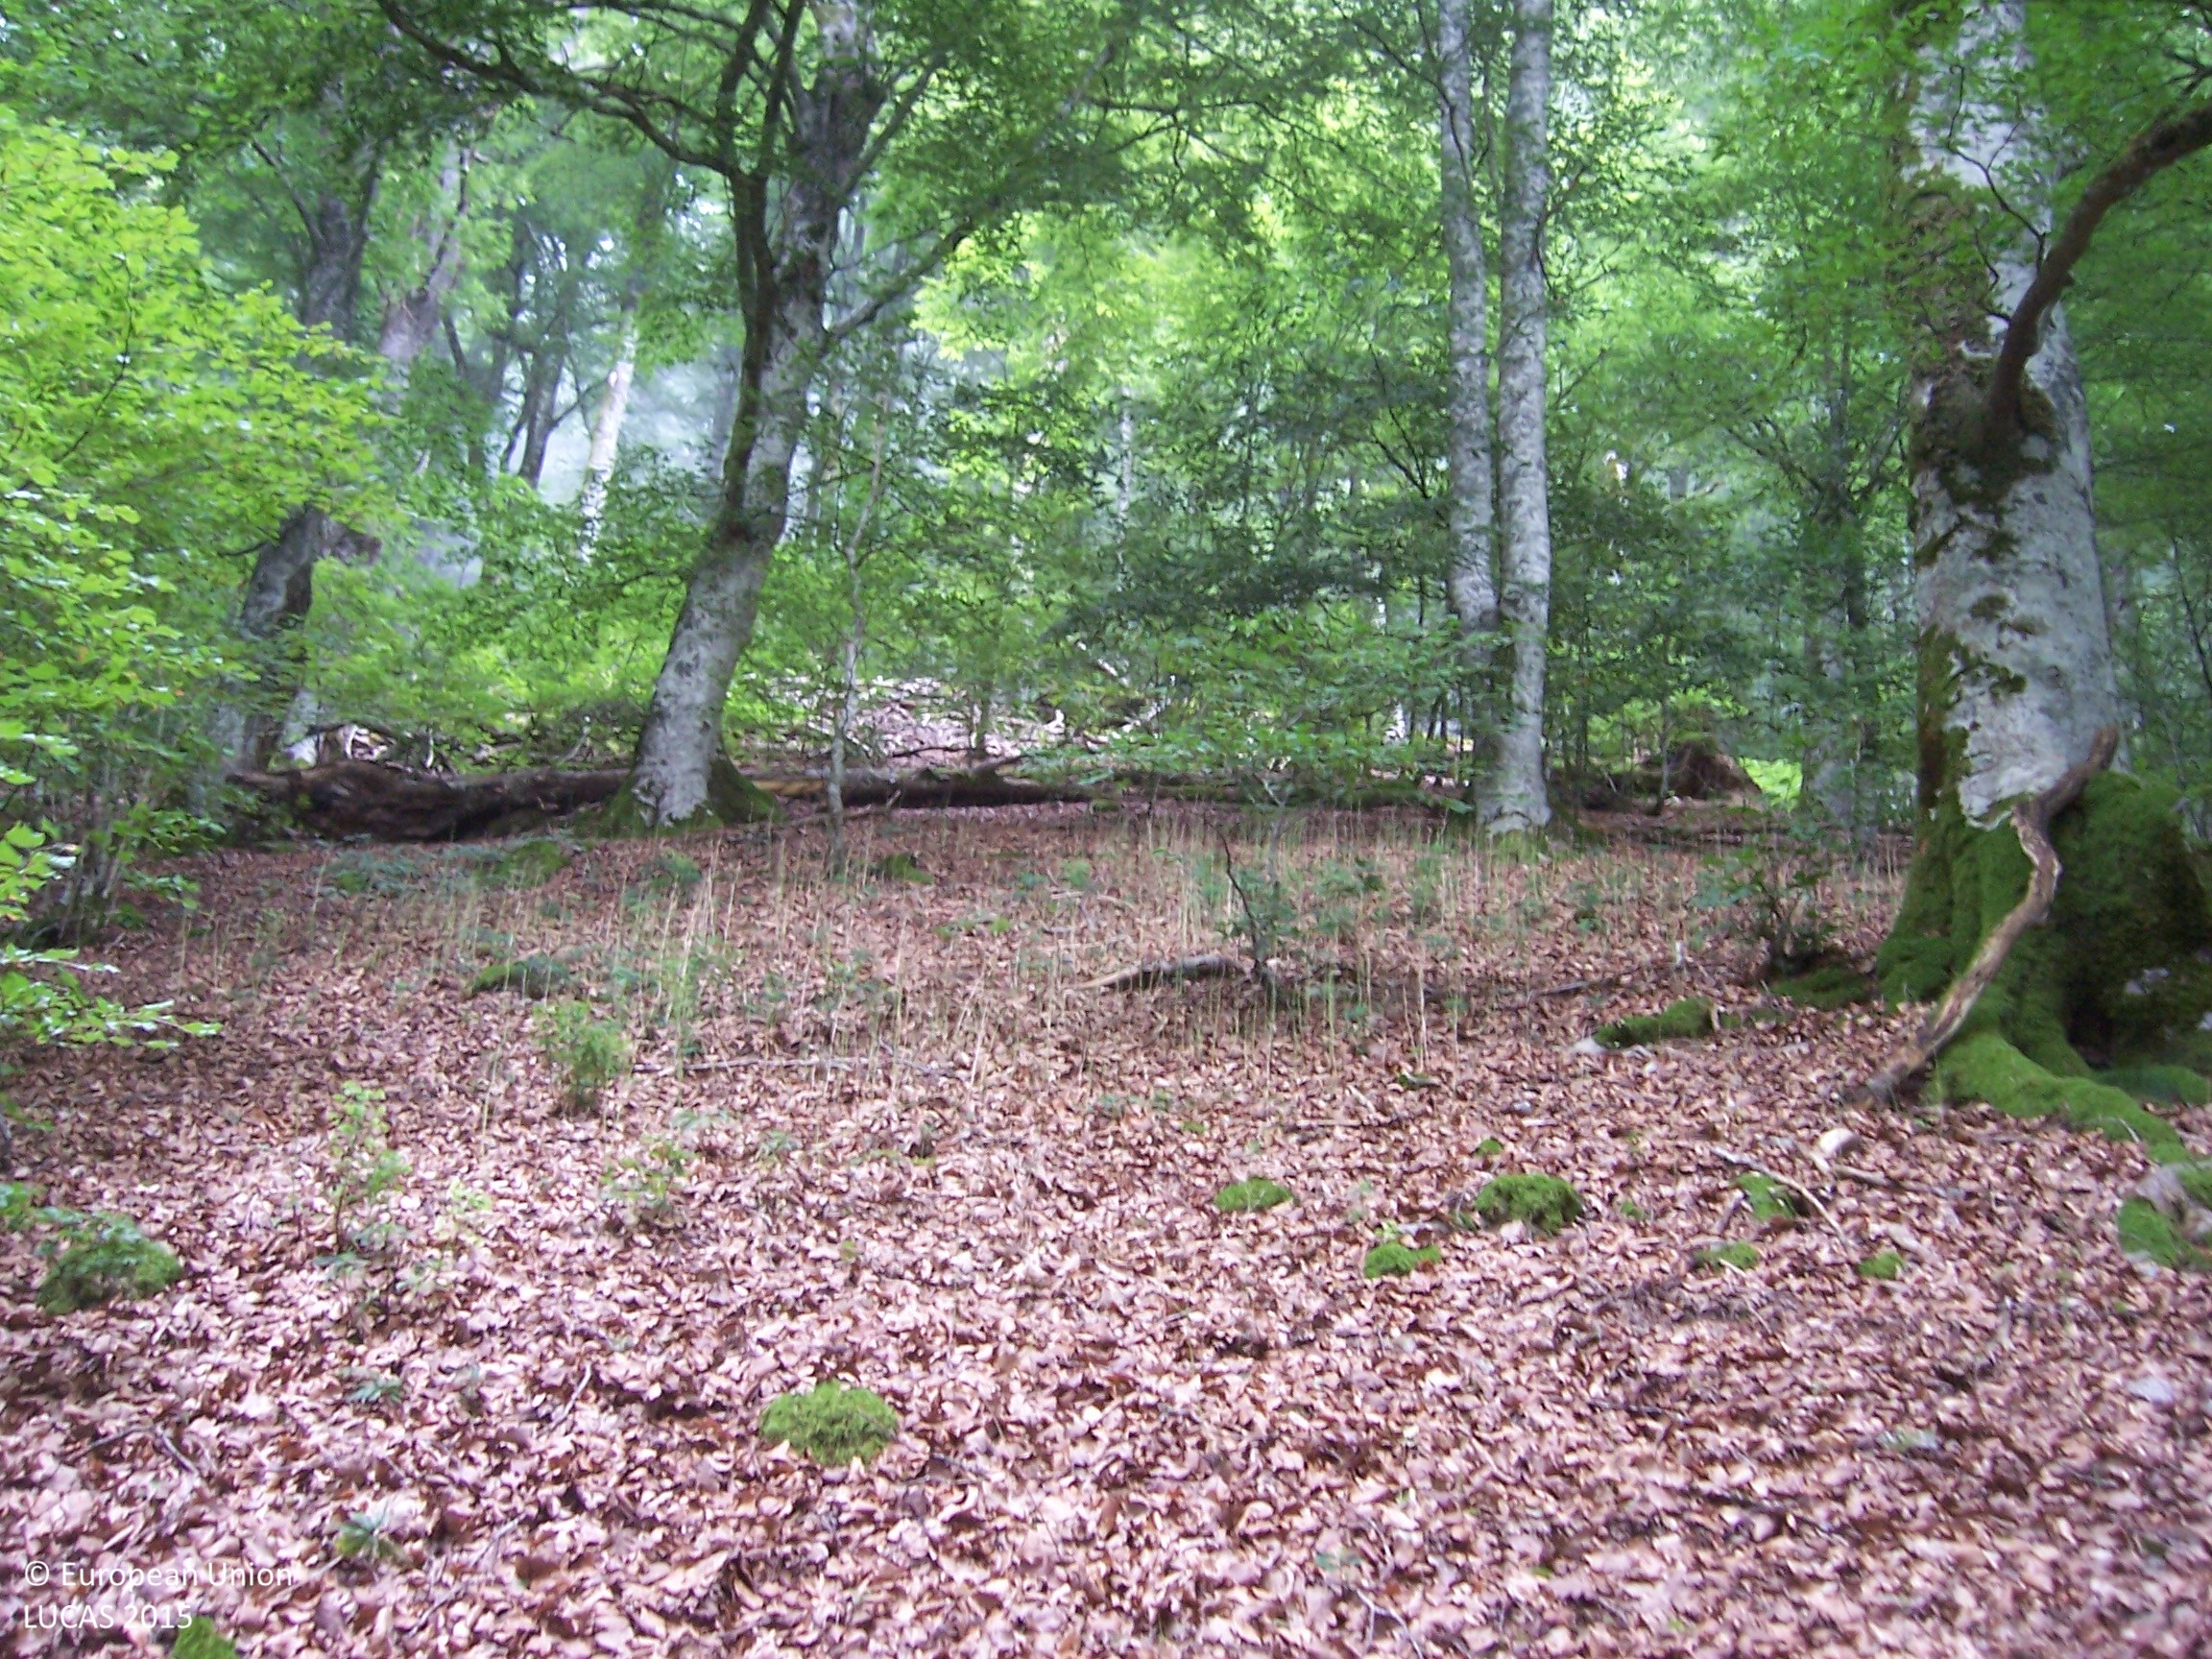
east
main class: Woodland
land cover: Broadleaved woodland
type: mountainous beech forest
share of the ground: > 75 %
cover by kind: broadleaved forest trees 100 %
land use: Forestry
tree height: > 5 m
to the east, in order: Broadleaved woodland
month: July
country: ES
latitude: 43.0127
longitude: -1.2138
